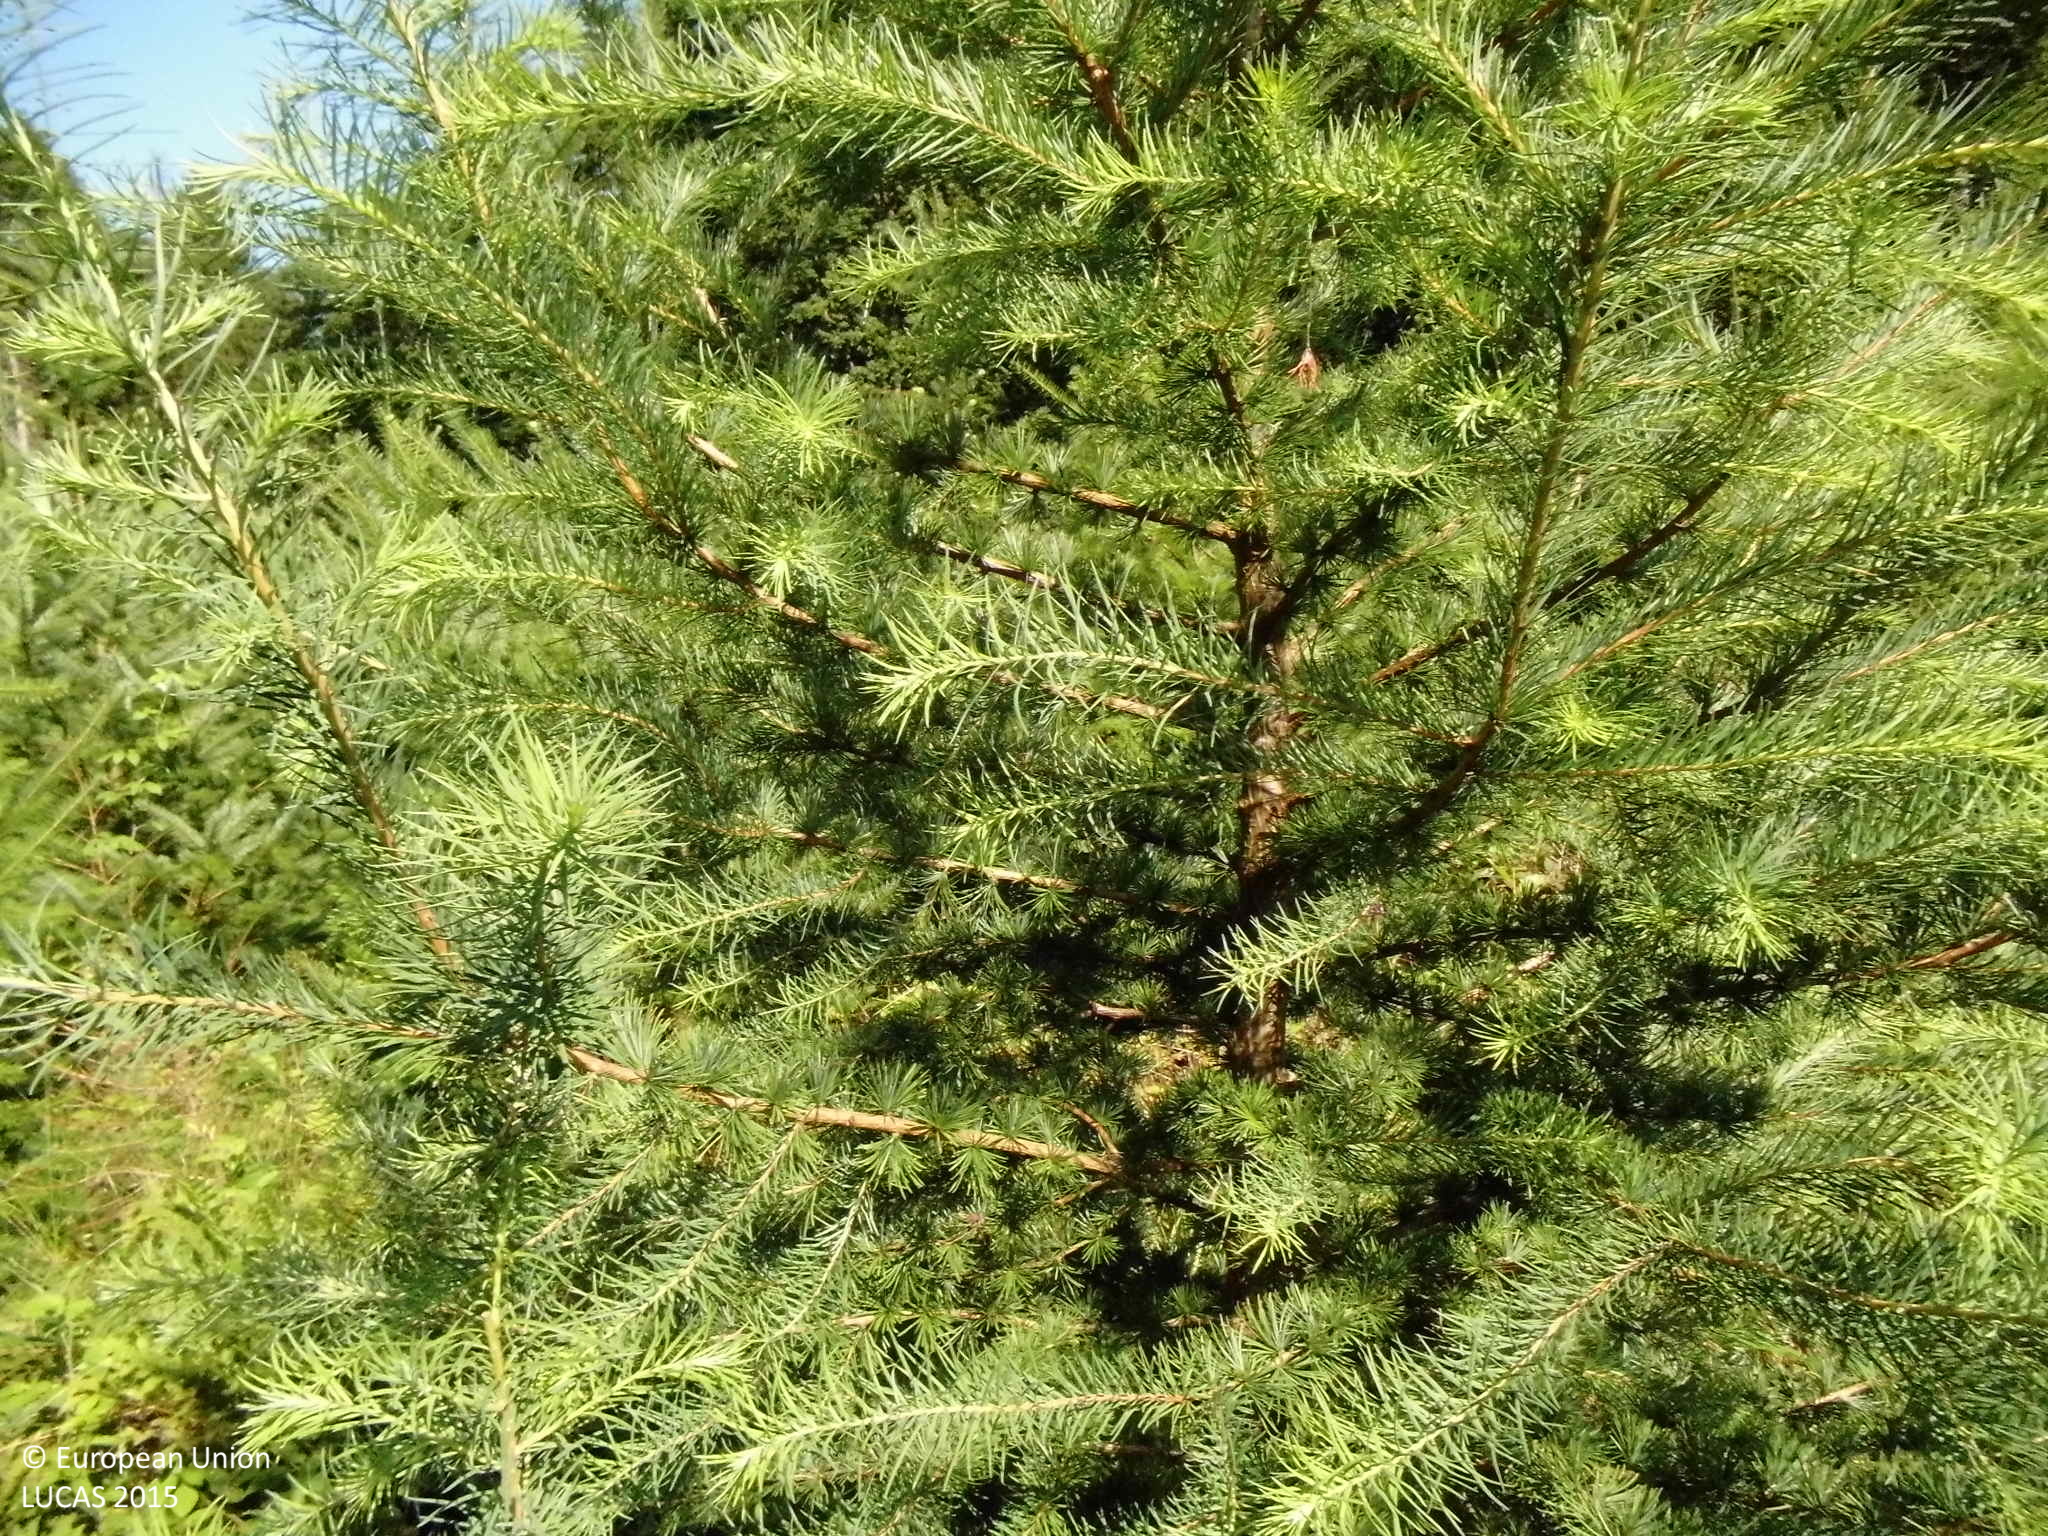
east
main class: Woodland
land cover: Other coniferous woodland
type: hemiboreal forest and nemoral coniferous forest and mixed broadleaved-coniferous forest
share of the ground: 25 - 50 %
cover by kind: coniferous forest trees 45 %, herbaceous plants 25 %, broadleaved forest trees 15 %, shrubs 15 %
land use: Forestry
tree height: < 5 m
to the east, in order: Other coniferous woodland; Shrubland with sparse tree cover; Tracks; Broadleaved woodland; Spruce dominated coniferous woodland; Broadleaved woodland
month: August
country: DE
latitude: 51.1556
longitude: 7.9844
